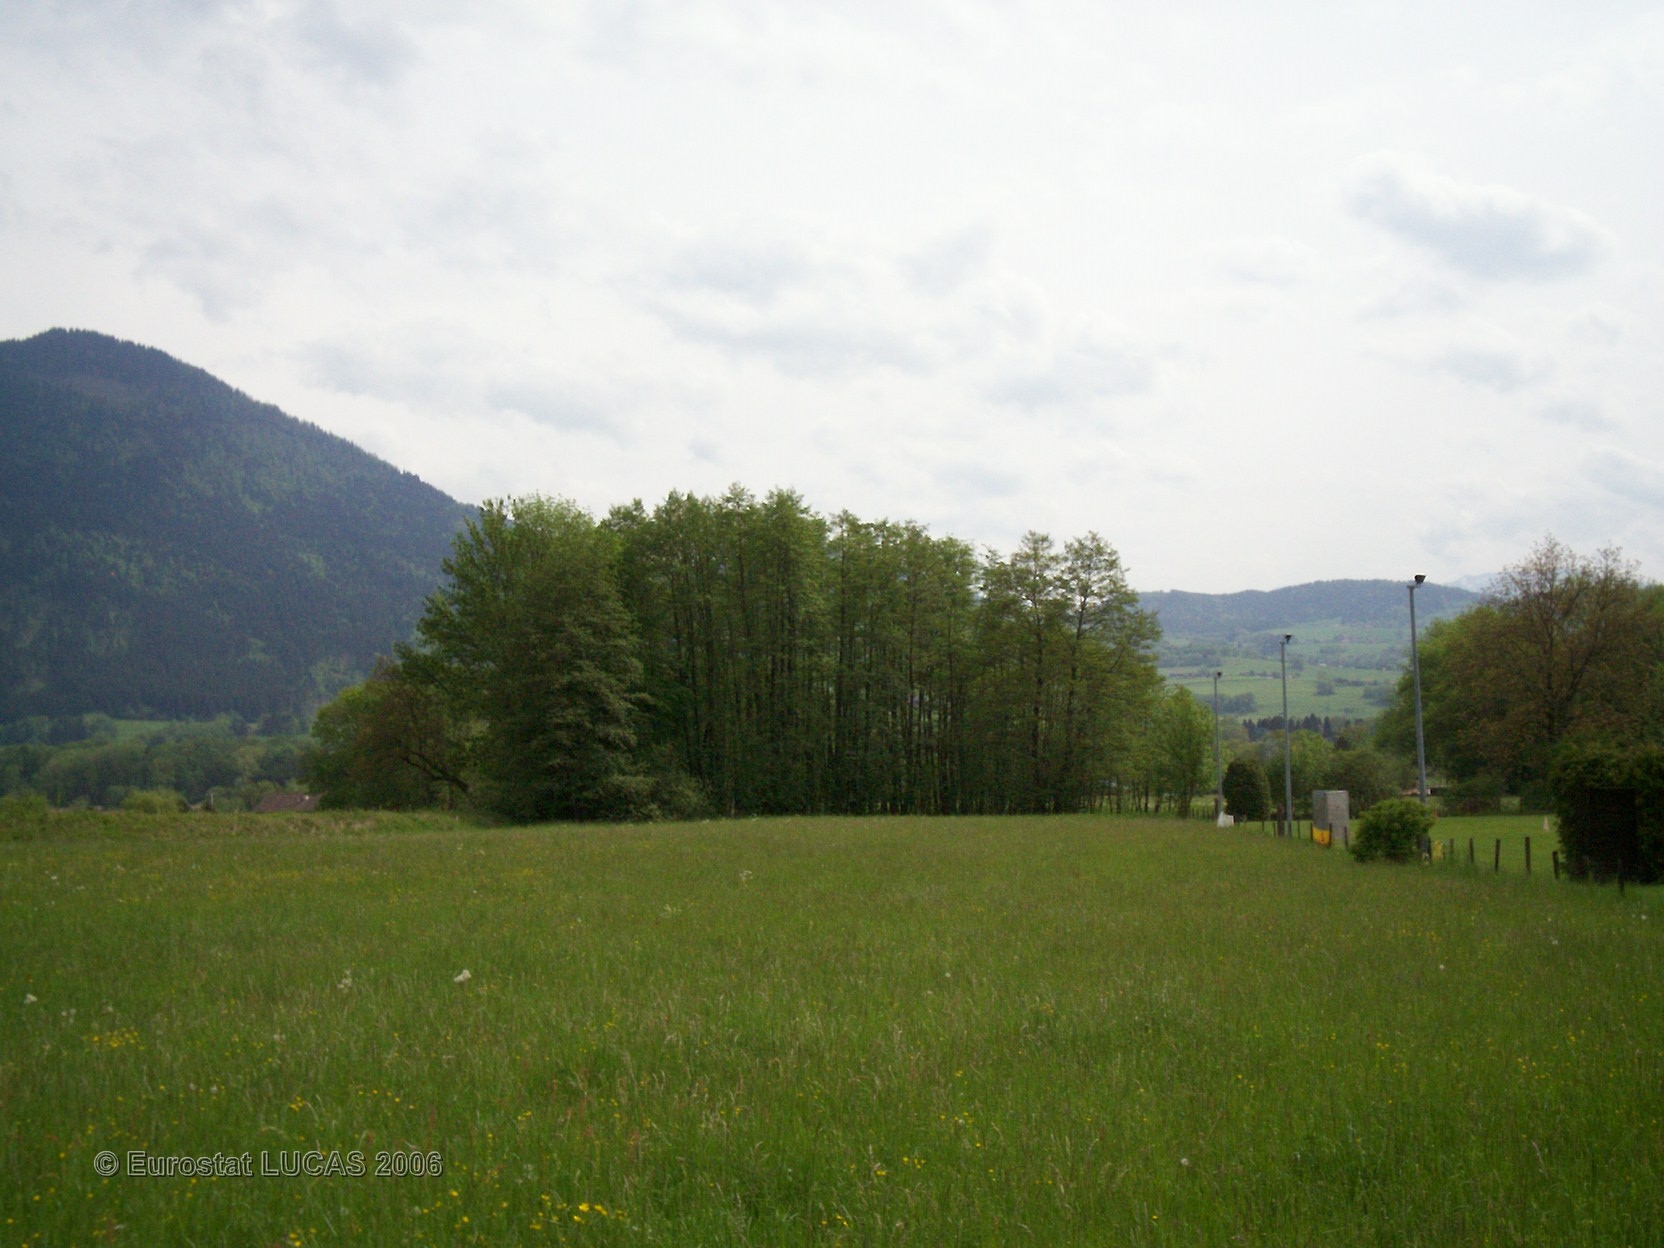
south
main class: Grassland
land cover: Grassland without tree/shrub cover
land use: Agriculture (excluding fallow land and kitchen gardens)
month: May
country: FR
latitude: 46.1470
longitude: 6.4173
